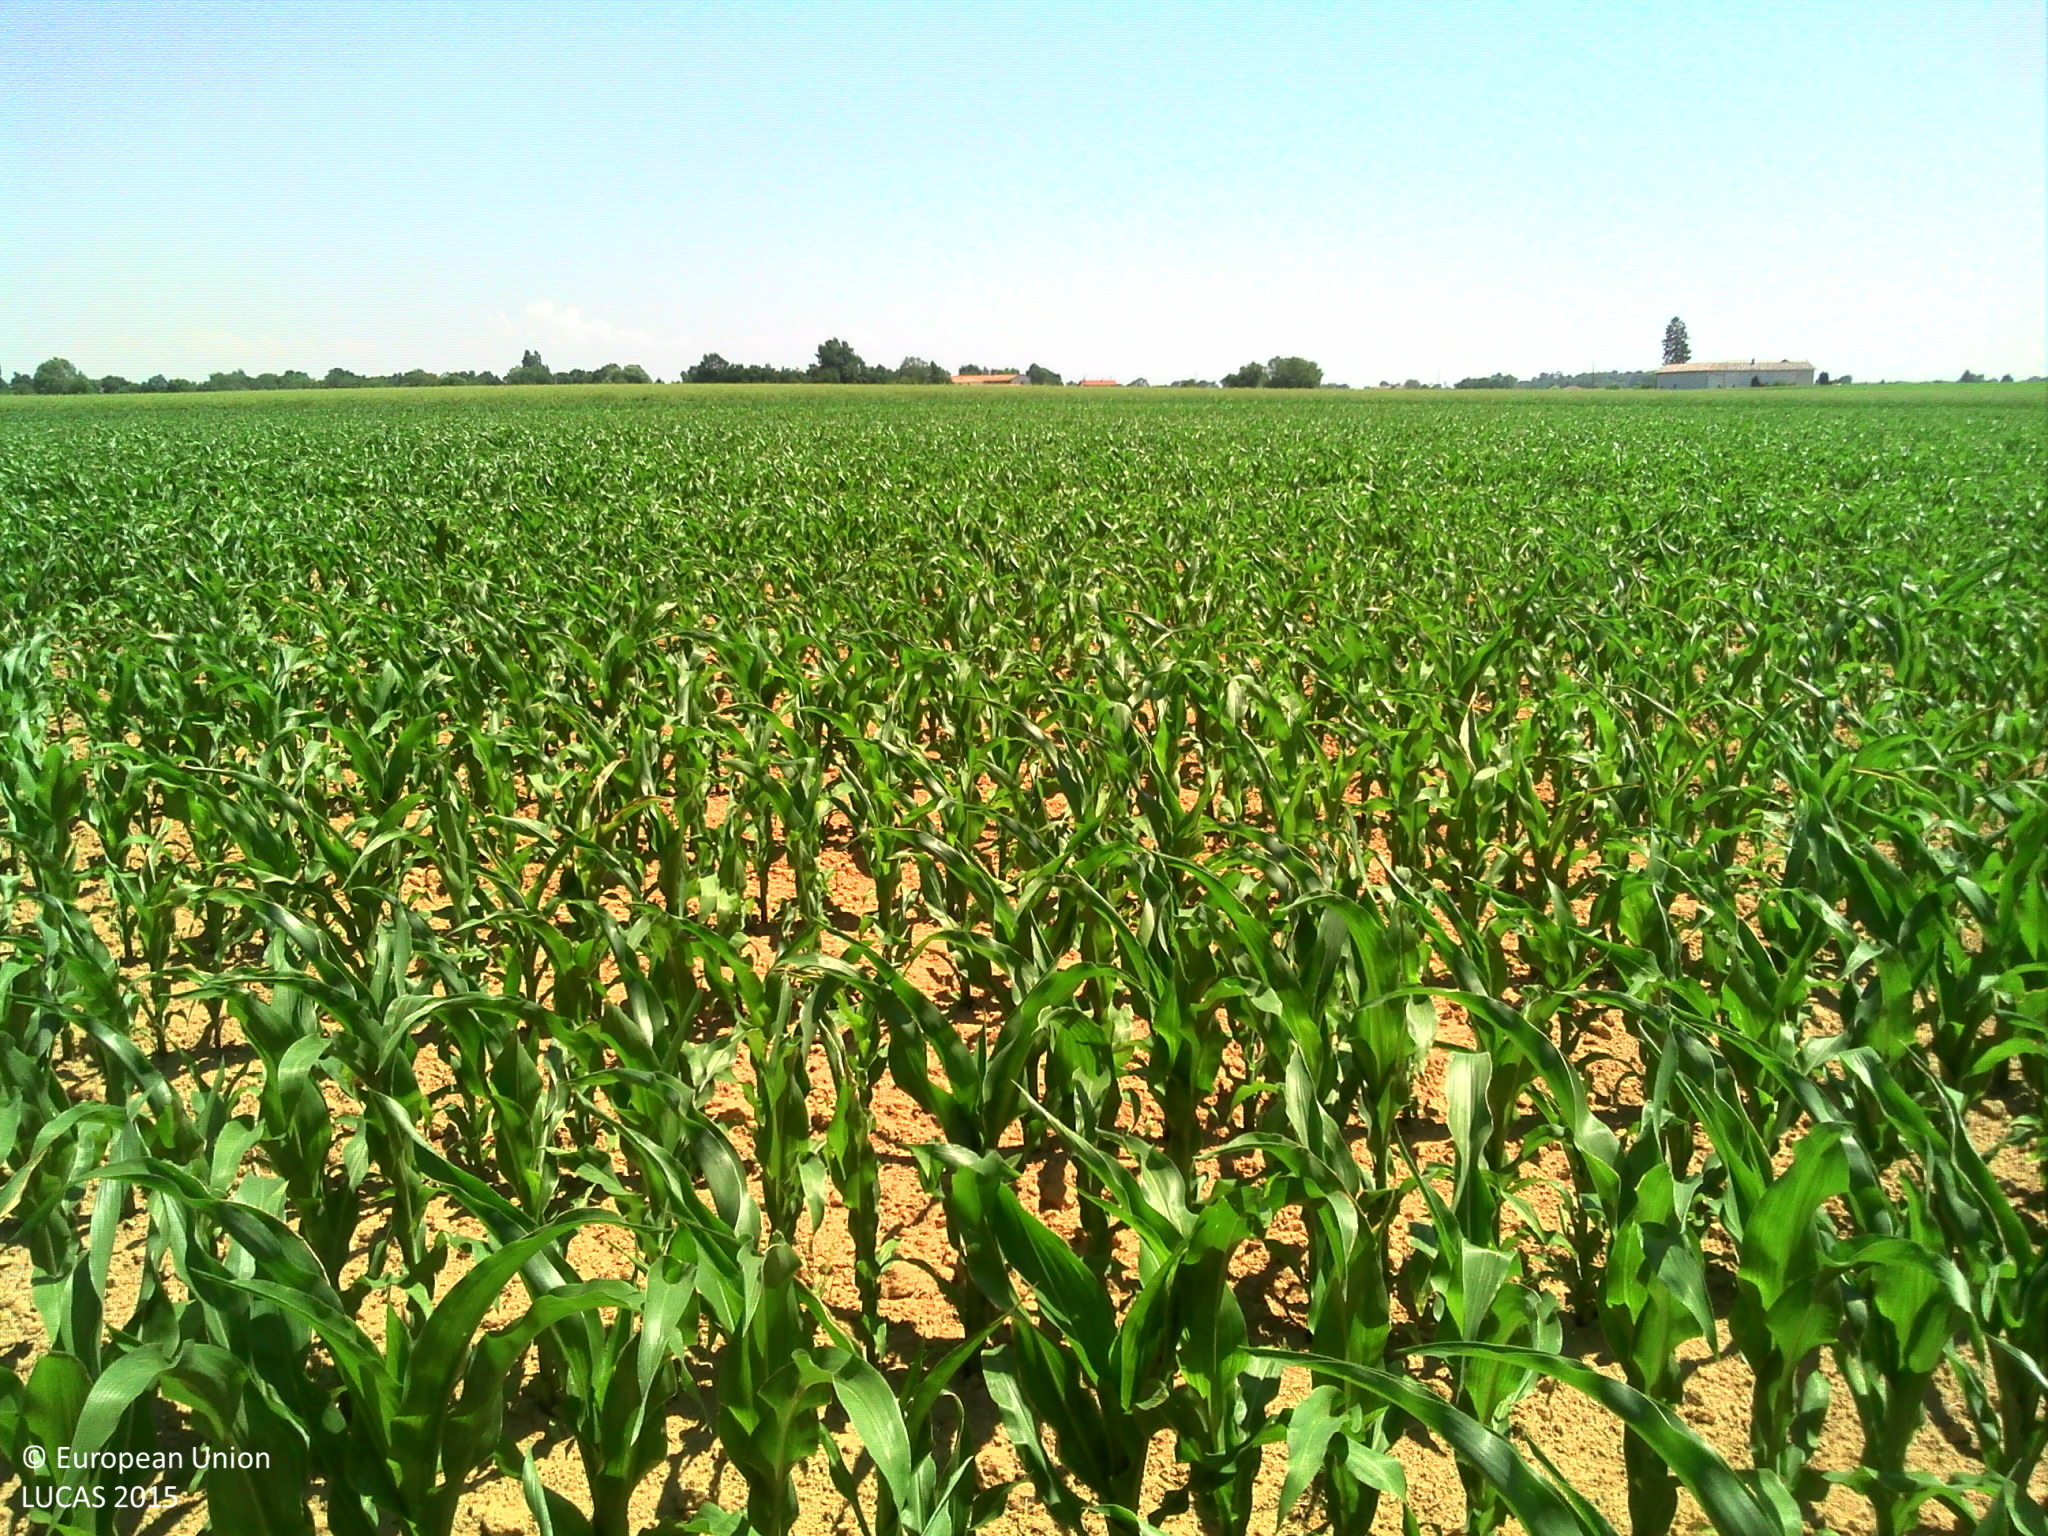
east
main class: Cropland
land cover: Maize
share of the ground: 10 - 25 %
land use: Agriculture (excluding fallow land and kitchen gardens)
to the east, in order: Maize; Rape and turnip rape
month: June
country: FR
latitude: 46.0093
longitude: 4.8242
